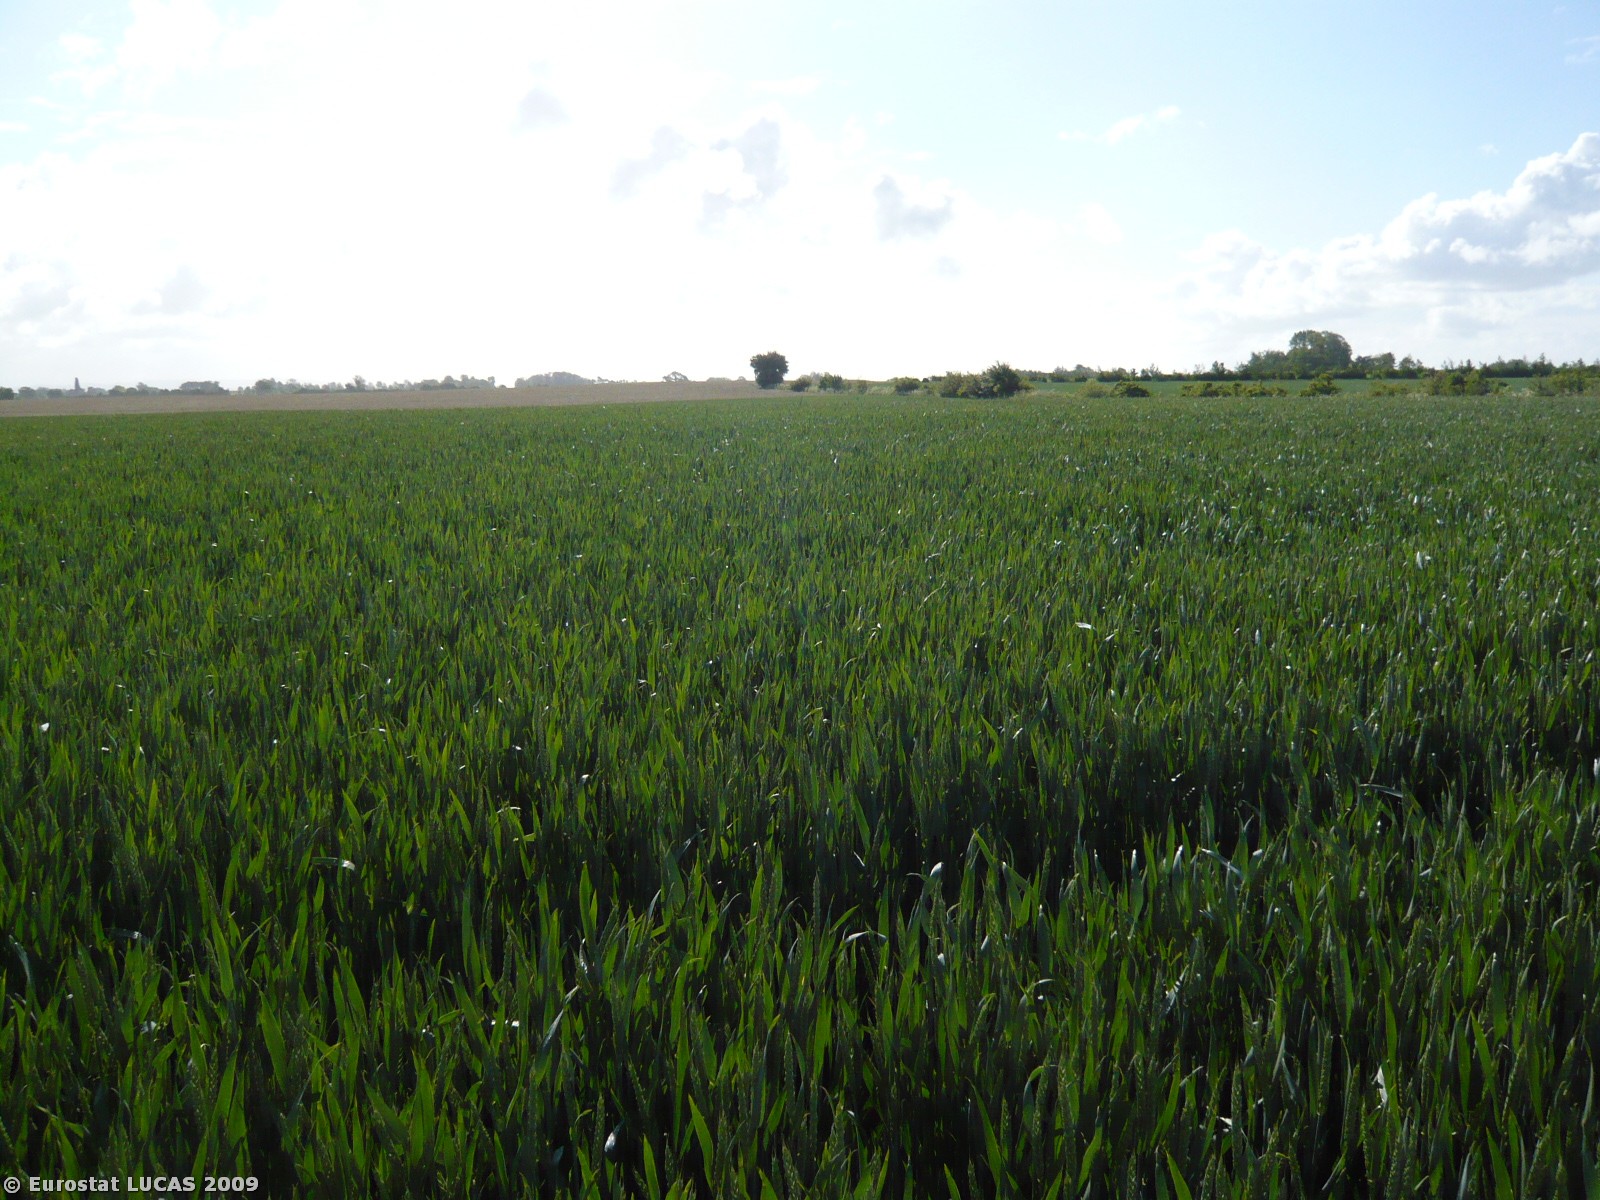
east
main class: Cropland
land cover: Common wheat
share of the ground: > 75 %
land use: Agriculture (excluding fallow land and kitchen gardens)
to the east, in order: Common wheat; Temporary grasslands
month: June
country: DK
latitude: 54.9451
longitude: 12.2623
